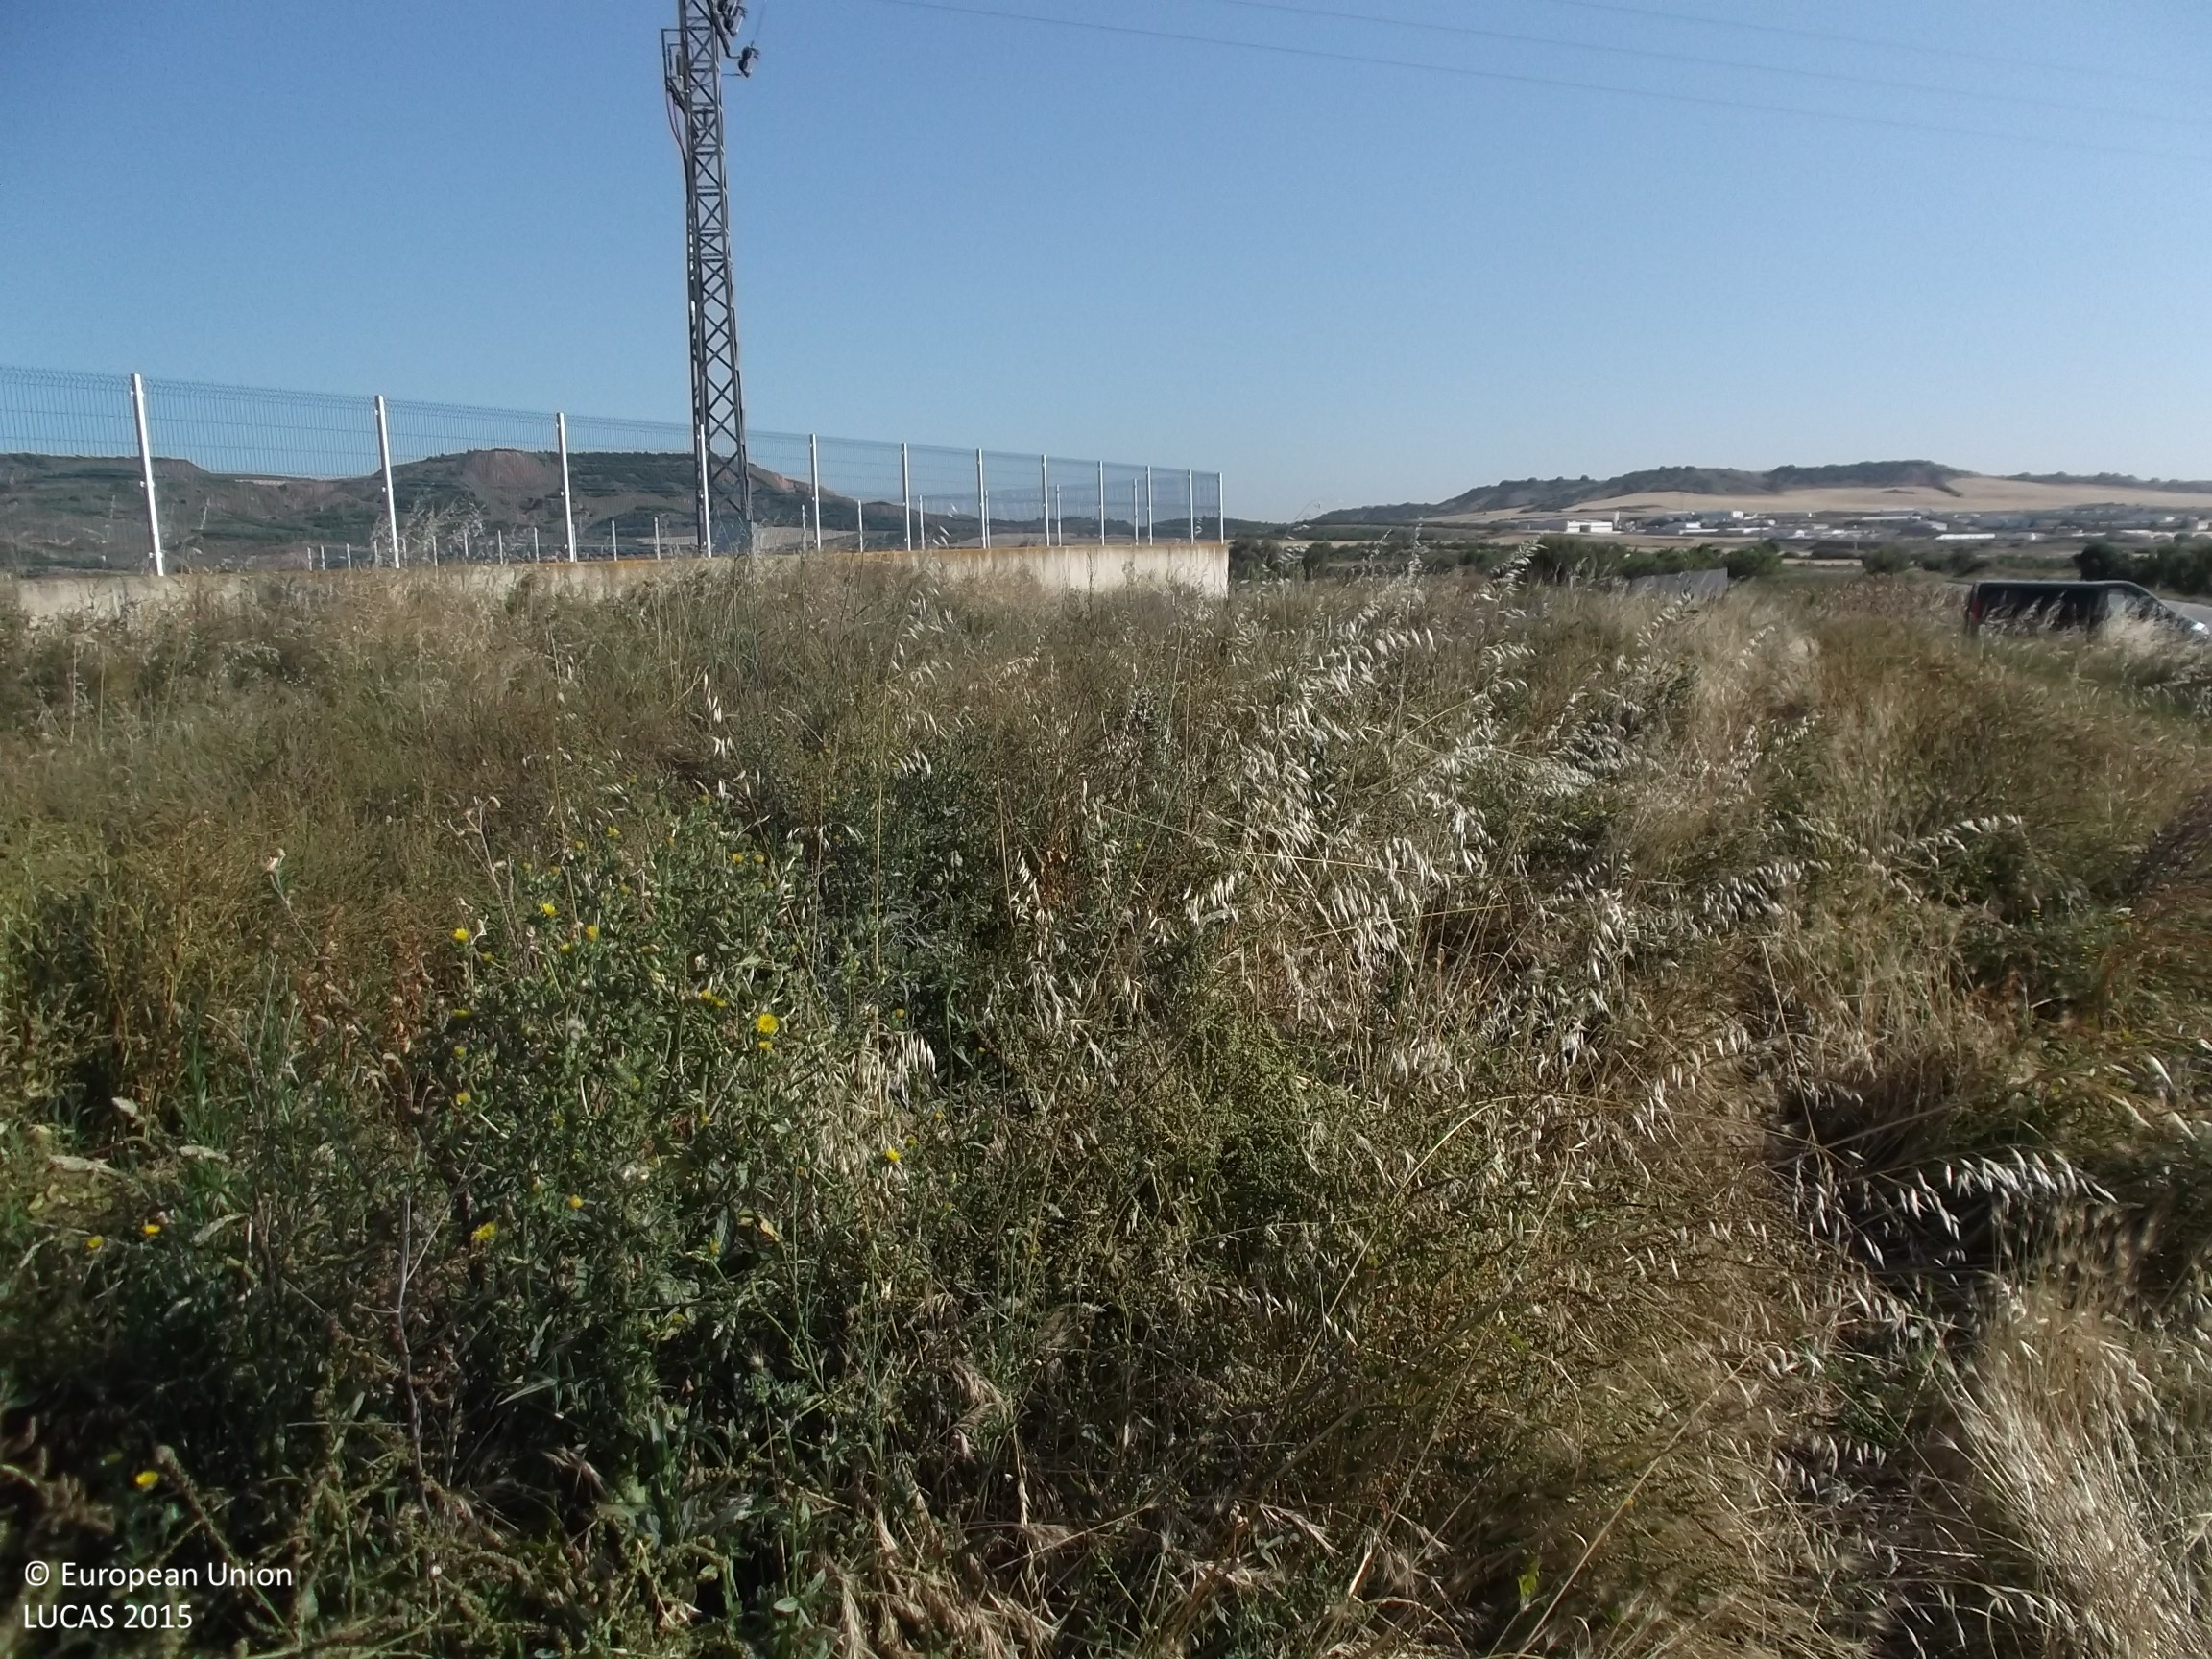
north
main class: Grassland
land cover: Spontaneously vegetated surfaces
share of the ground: > 75 %
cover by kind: herbaceous plants 95 %
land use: Abandoned areas
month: June
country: ES
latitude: 42.3283
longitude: -2.0898
